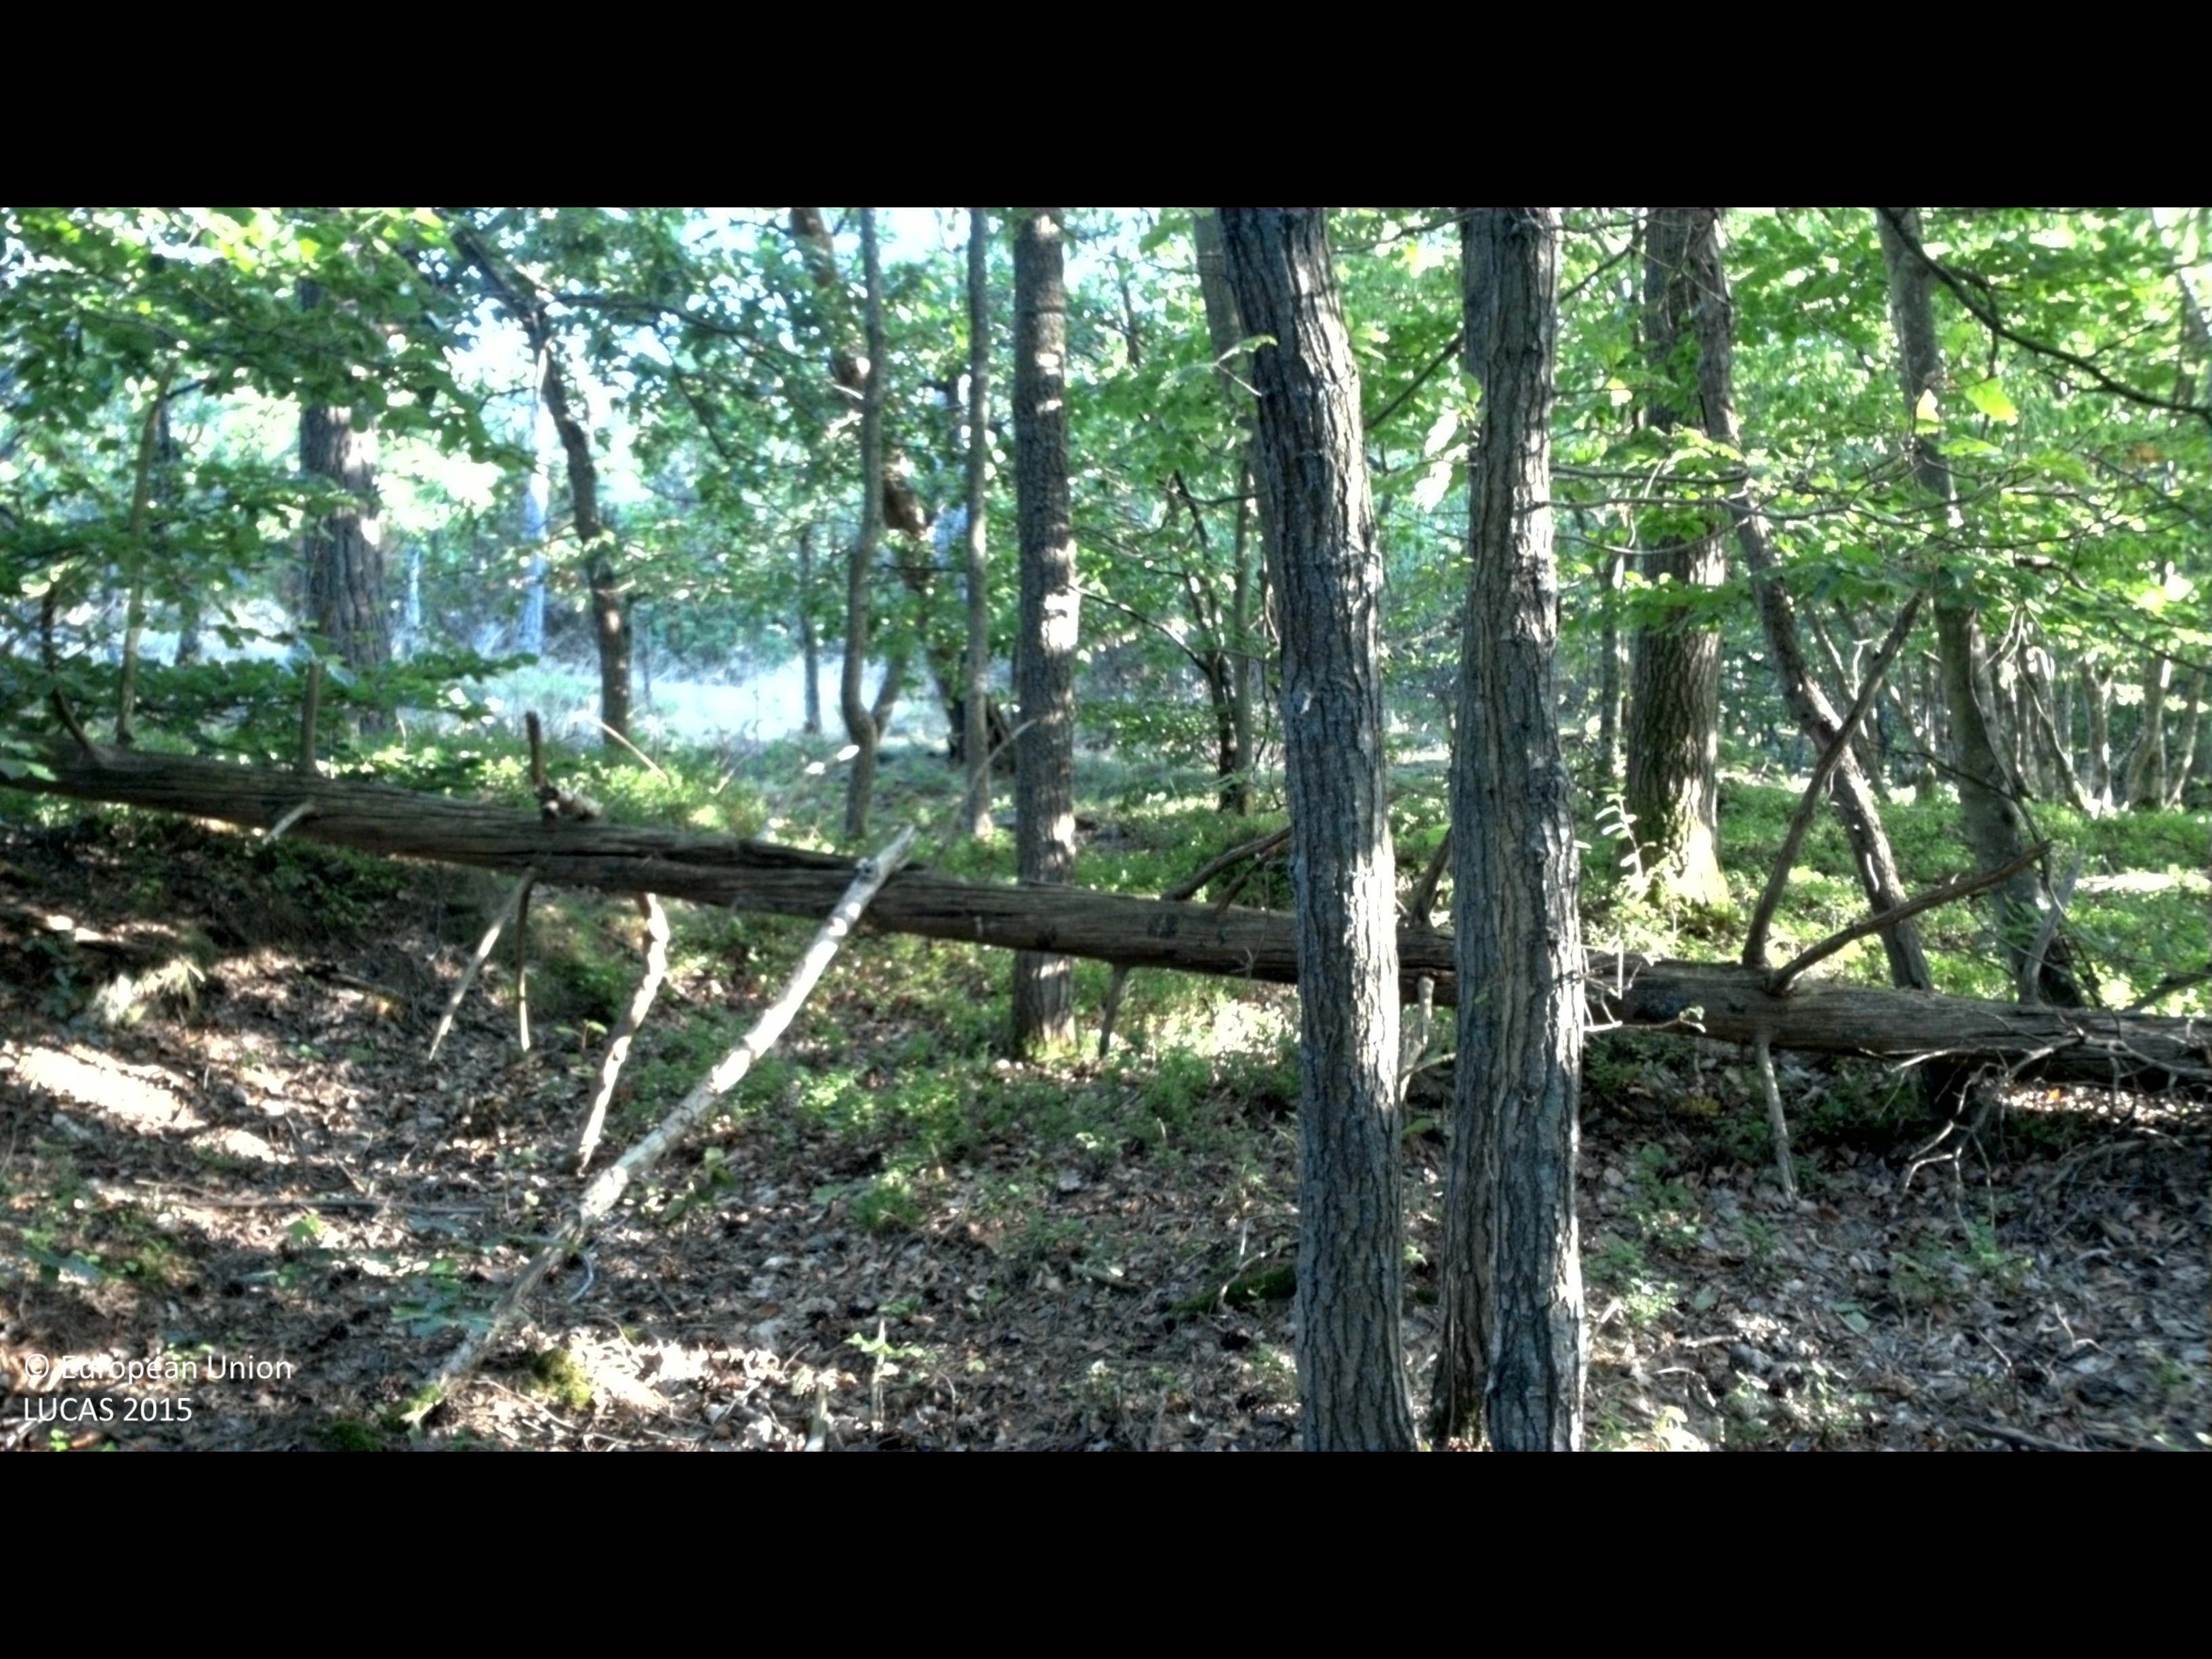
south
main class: Woodland
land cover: Broadleaved woodland
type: mesophytic deciduous forest
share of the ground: 50 - 75 %
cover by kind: broadleaved forest trees 60 %, herbaceous plants 10 %, coniferous forest trees 5 %, lichens and mosses 5 %
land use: Forestry
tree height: > 5 m
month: August
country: SE
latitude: 56.1865
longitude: 15.3002
